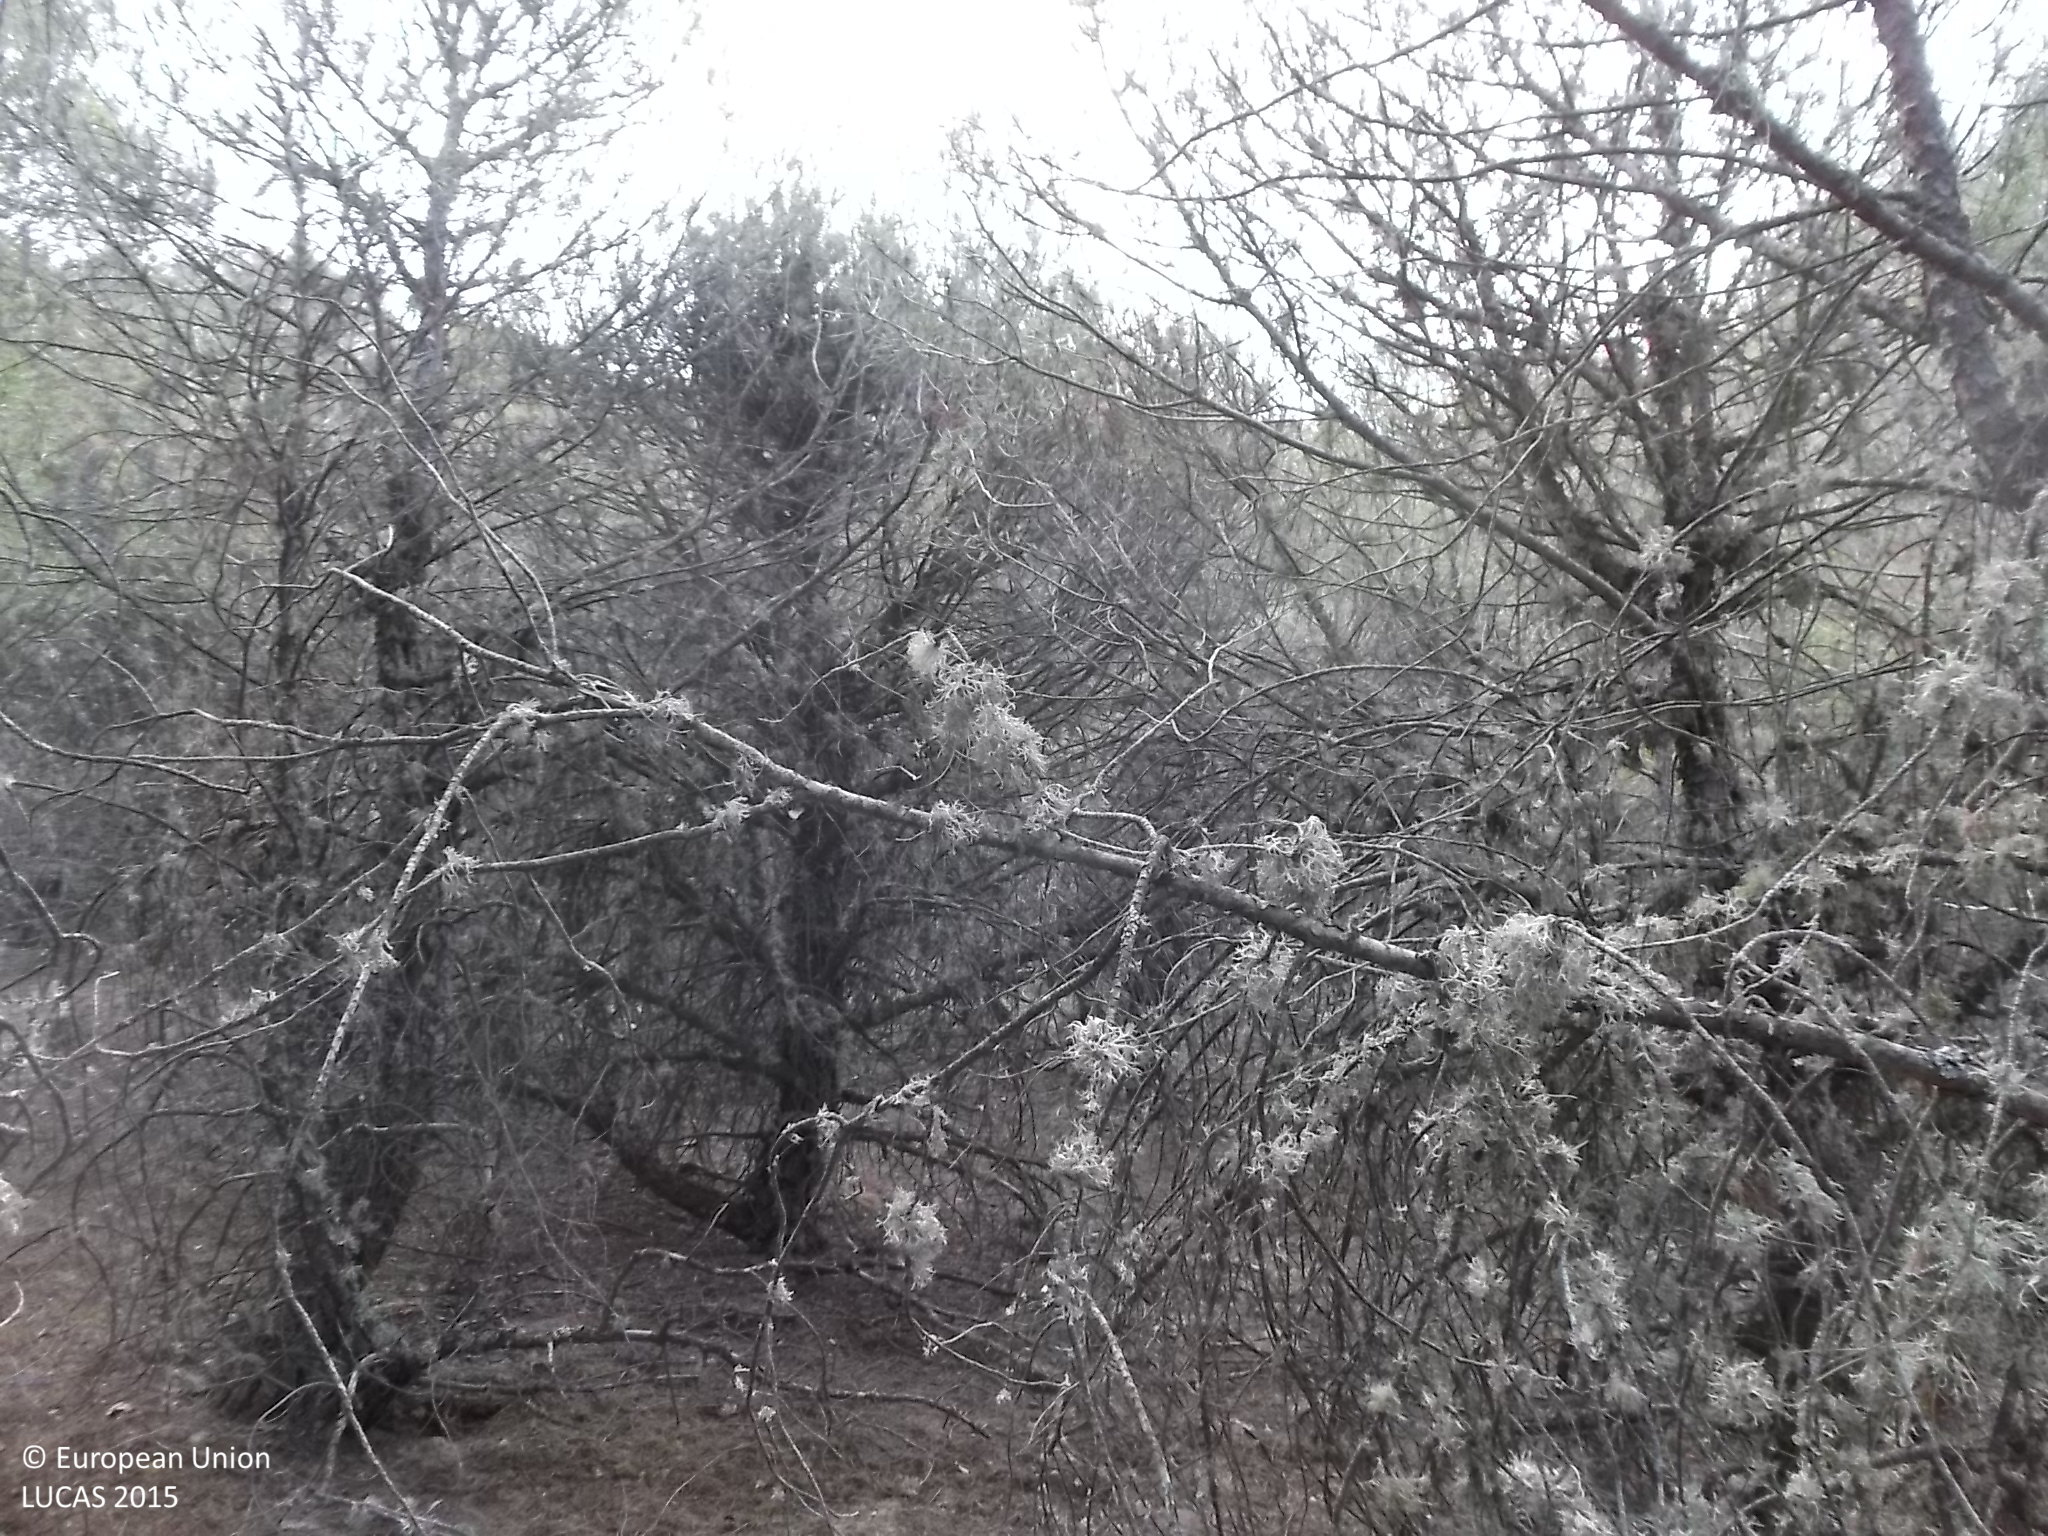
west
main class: Woodland
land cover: Pine dominated coniferous woodland
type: coniferous forest of the mediterranean region
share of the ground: > 75 %
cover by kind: coniferous forest trees 80 %, shrubs 20 %
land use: Semi-natural and natural areas not in use
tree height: > 5 m
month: July
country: ES
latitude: 41.5361
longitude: -5.4349
